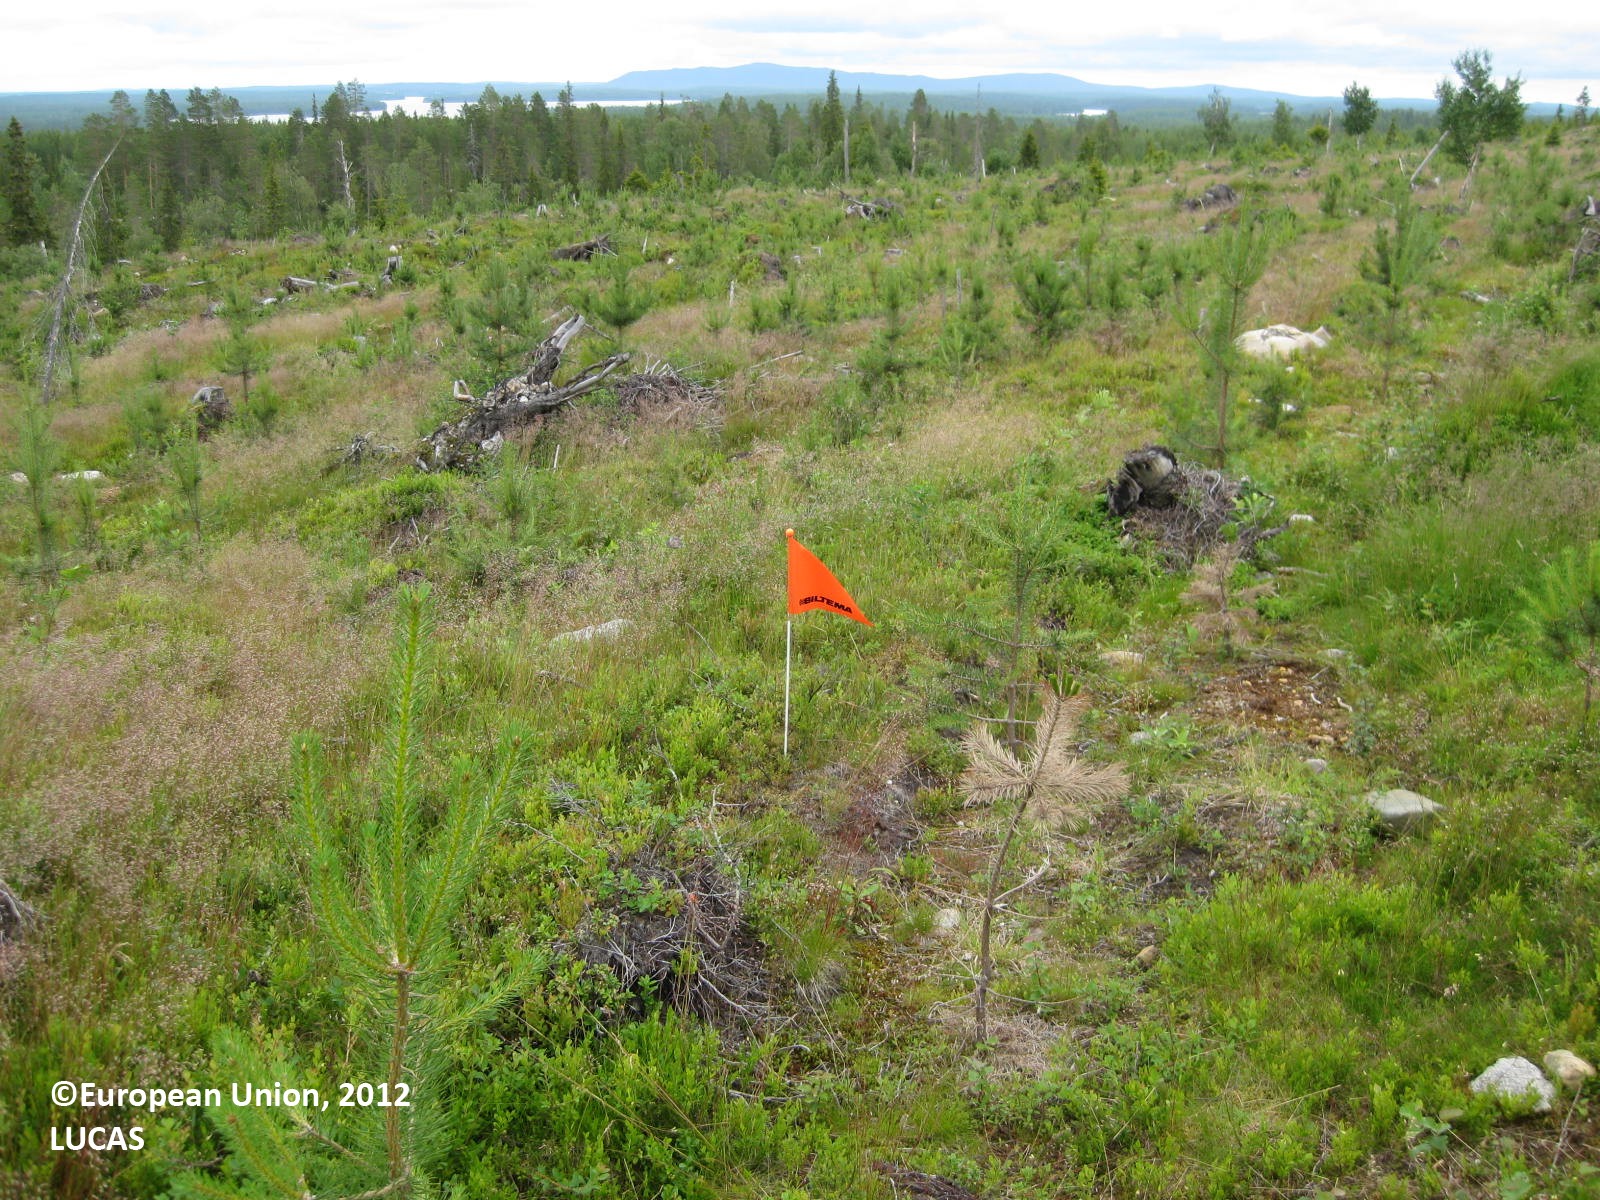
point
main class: Woodland
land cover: Pine dominated coniferous woodland
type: boreal forest
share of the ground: 10 - 25 %
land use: Forestry
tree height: < 5 m
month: July
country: FI
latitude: 65.8107
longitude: 29.3696
